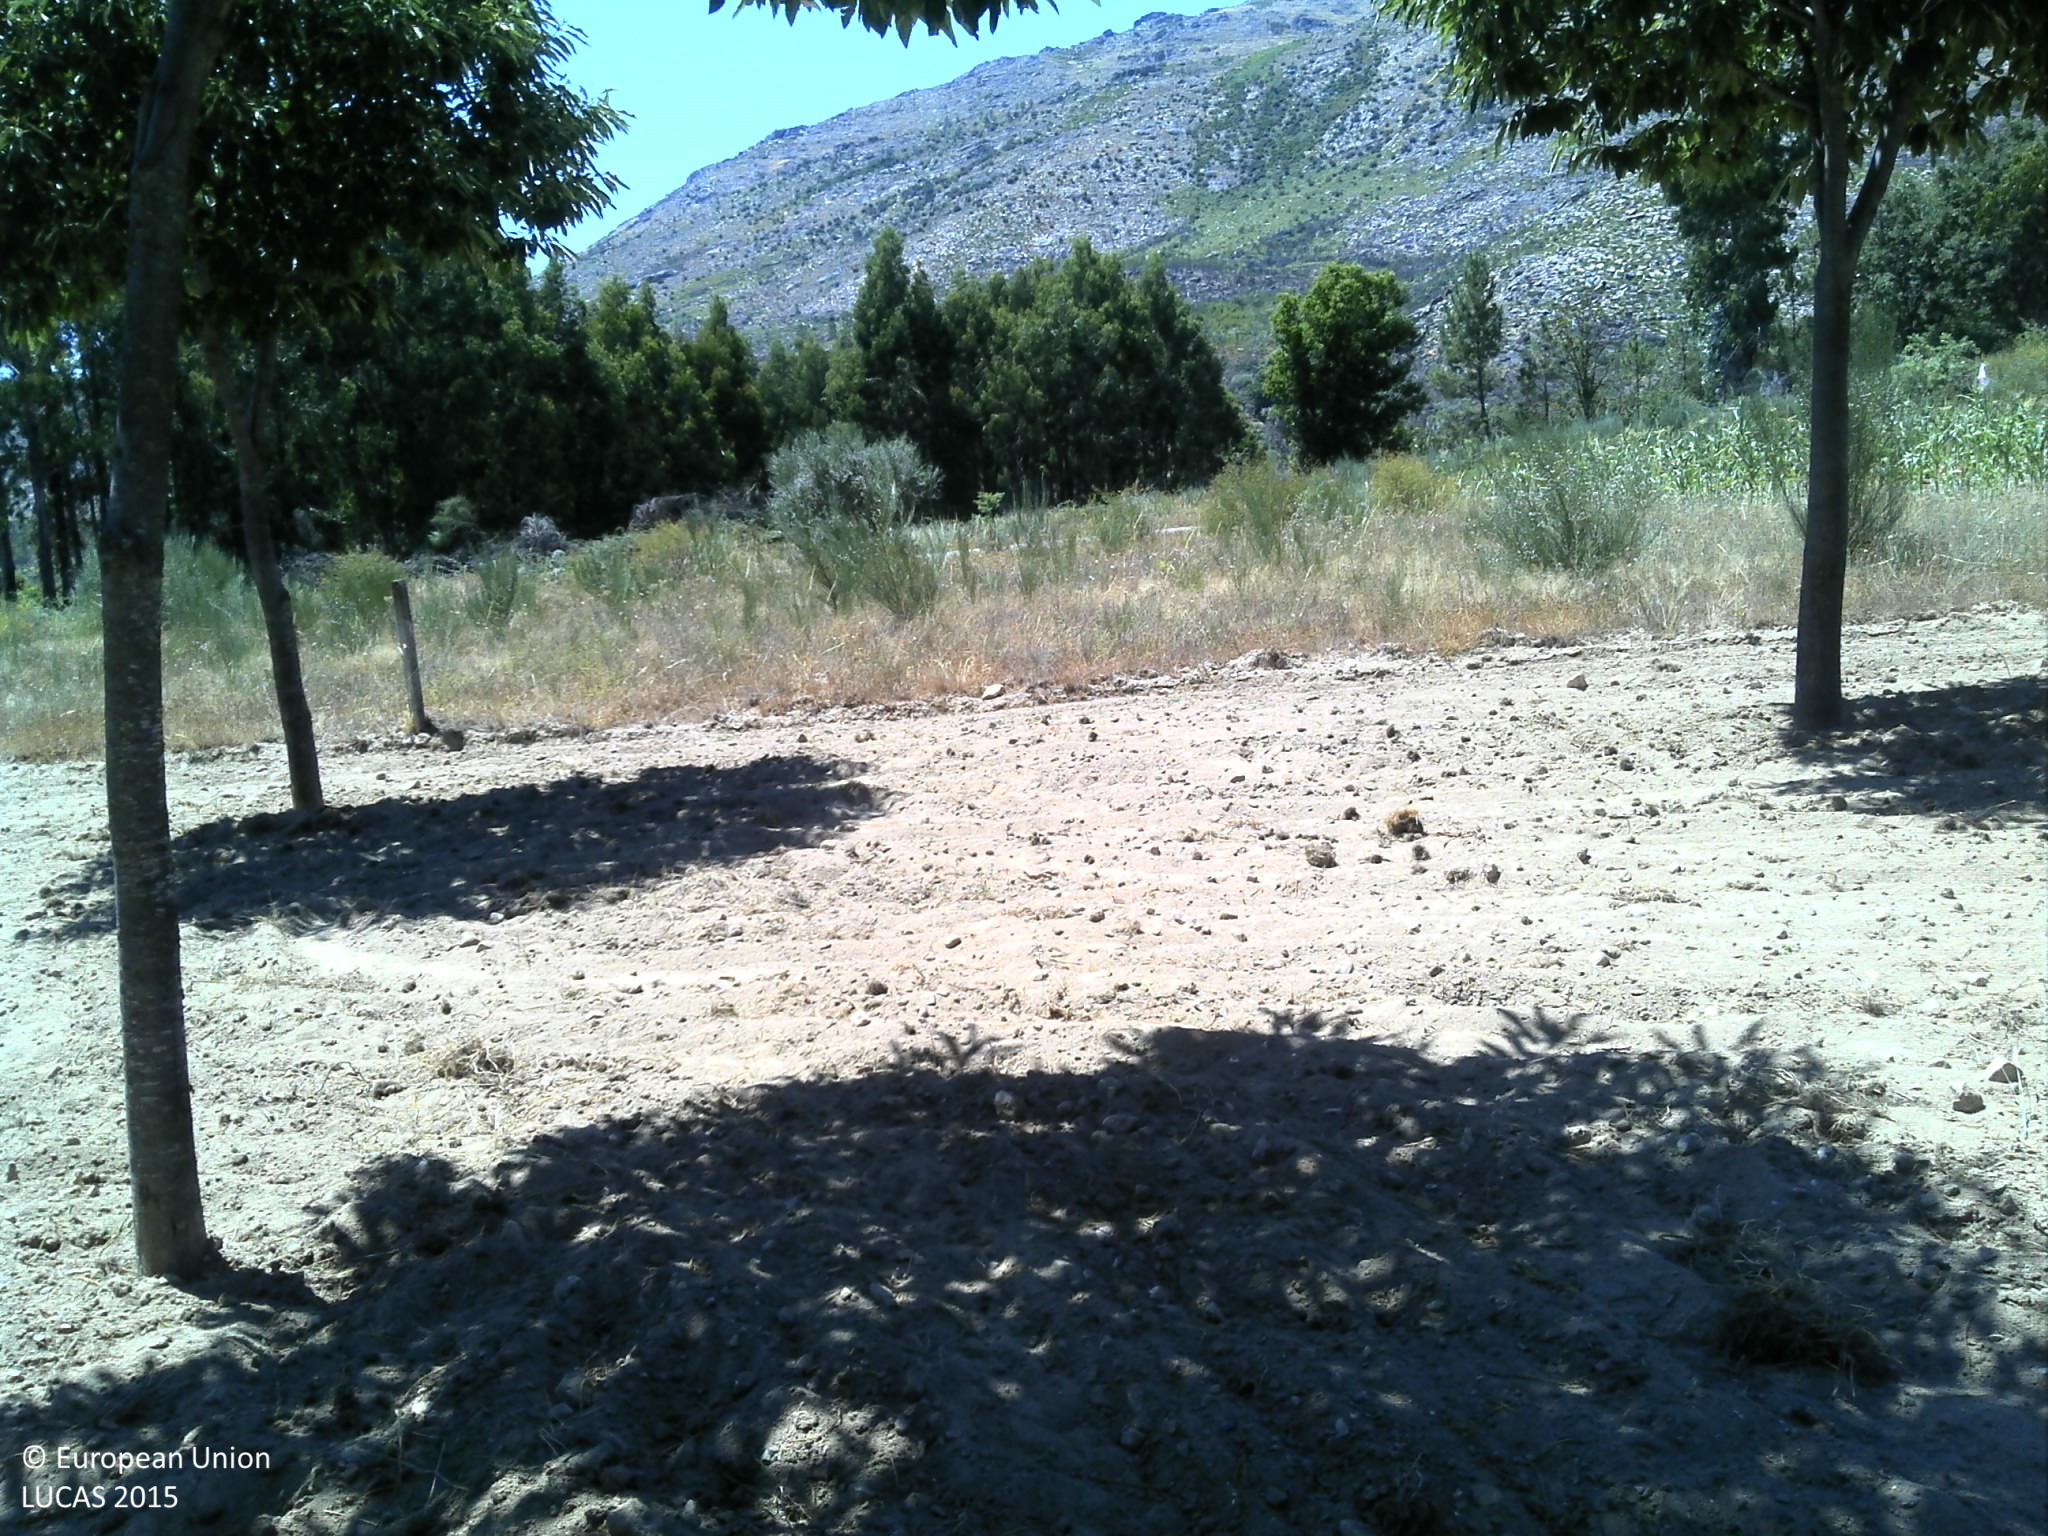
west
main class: Cropland
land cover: Nuts trees
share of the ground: 25 - 50 %
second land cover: Other bare soil
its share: > 75 %
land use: Agriculture (excluding fallow land and kitchen gardens)
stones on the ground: 10 - 25 %
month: July
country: PT
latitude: 41.7213
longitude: -7.6237
